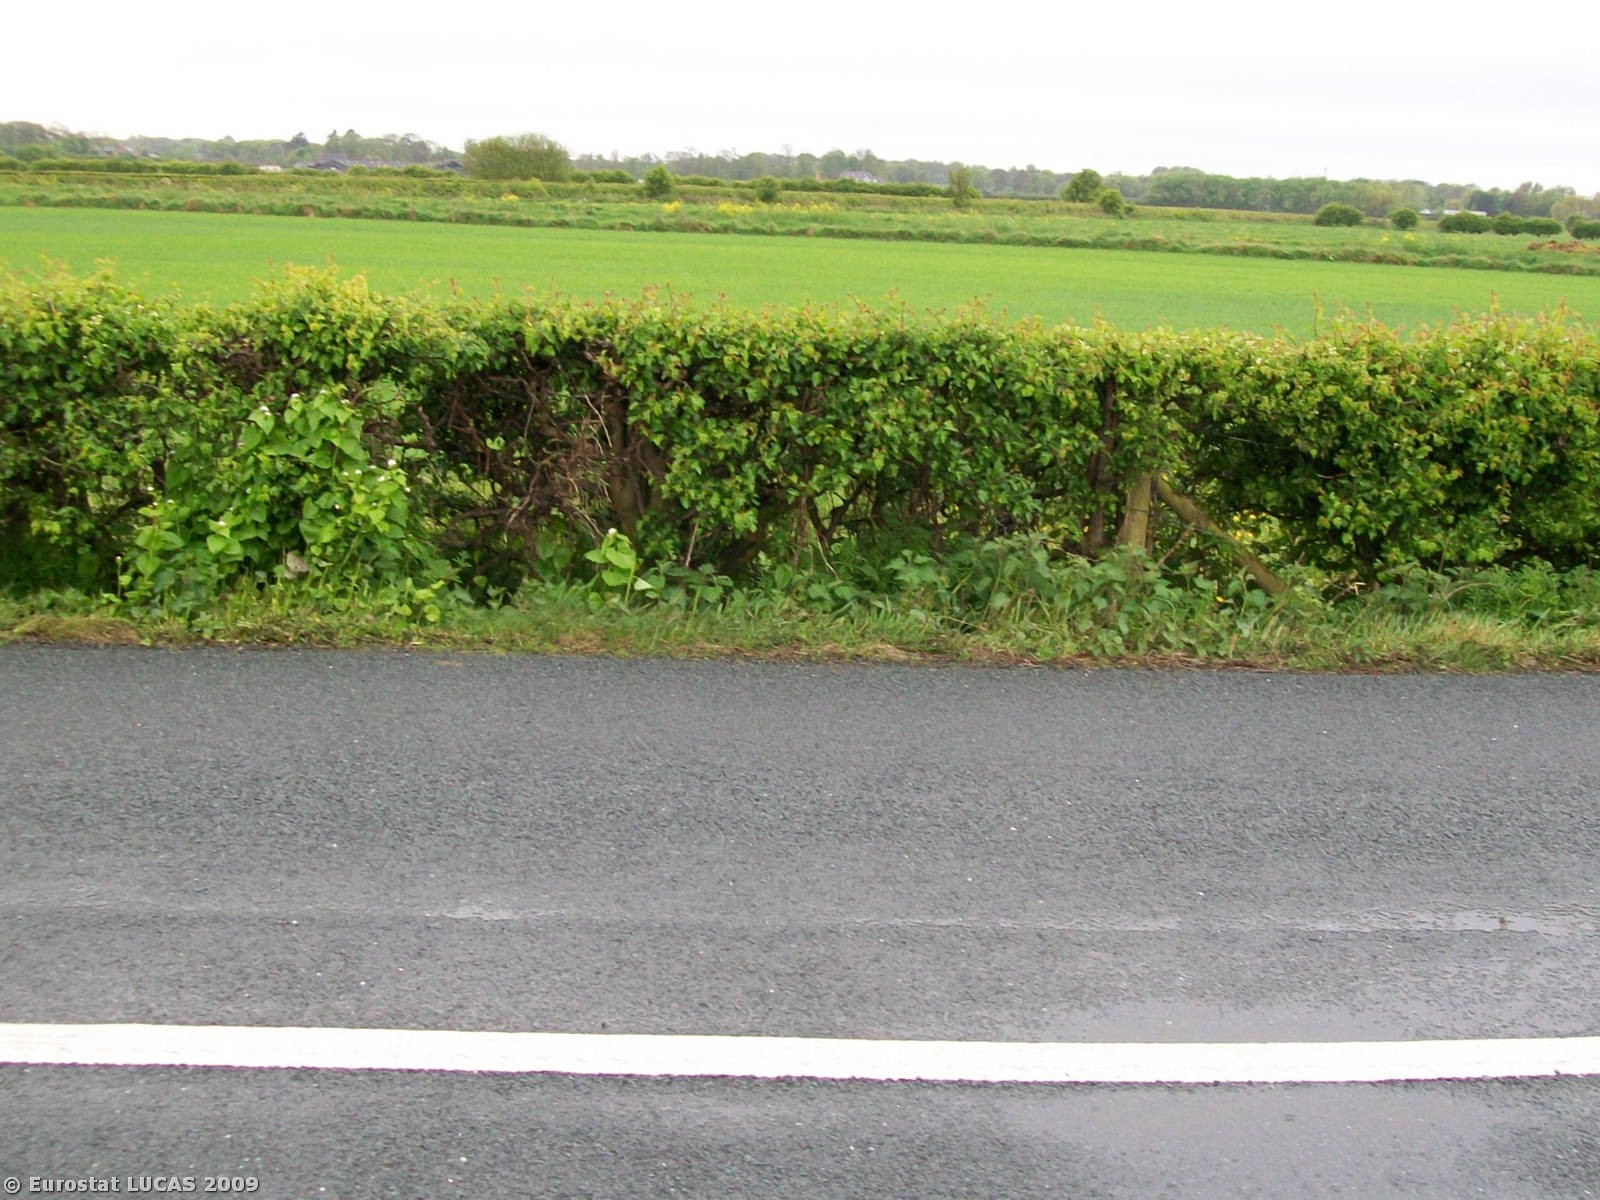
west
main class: Cropland
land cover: Barley
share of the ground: 50 - 75 %
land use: Agriculture (excluding fallow land and kitchen gardens)
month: May
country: GB
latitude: 53.7596
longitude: -2.9508
